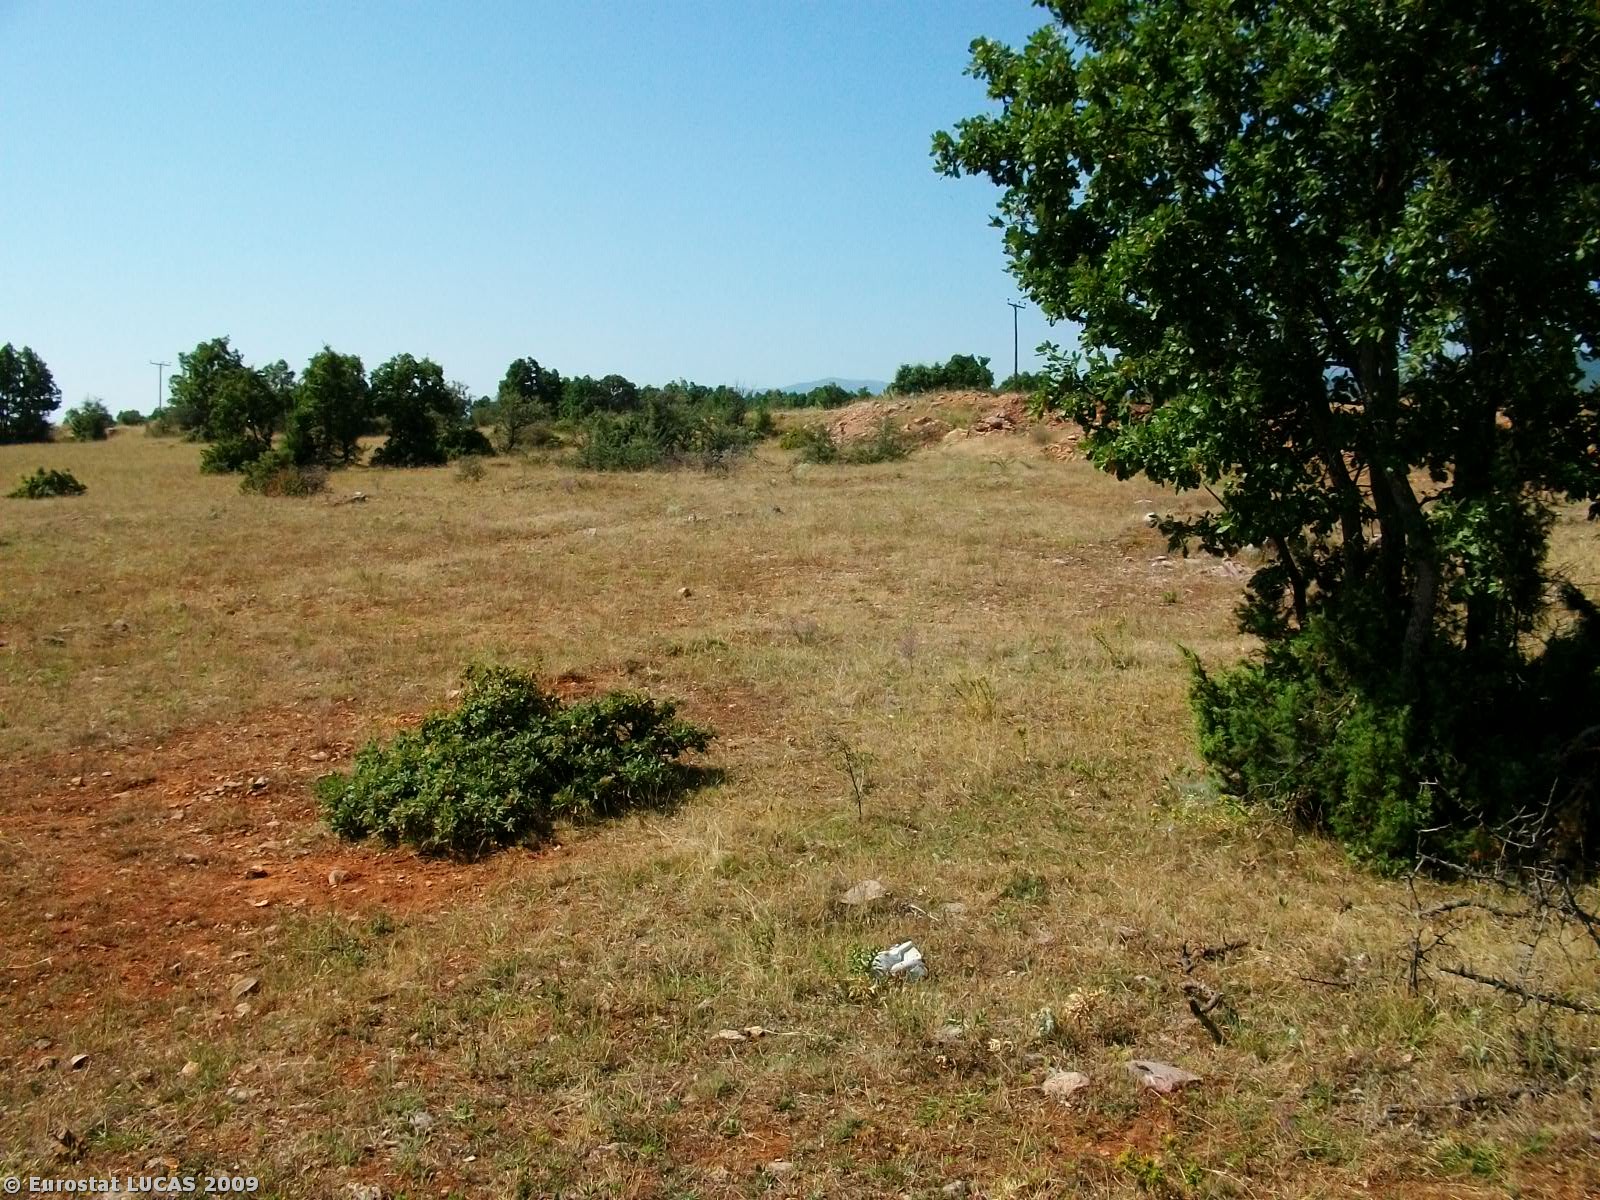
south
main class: Grassland
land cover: Grassland with sparse tree/shrub cover
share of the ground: > 75 %
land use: Agriculture (excluding fallow land and kitchen gardens)
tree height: > 5 m
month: July
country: GR
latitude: 40.2722
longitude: 21.7395
